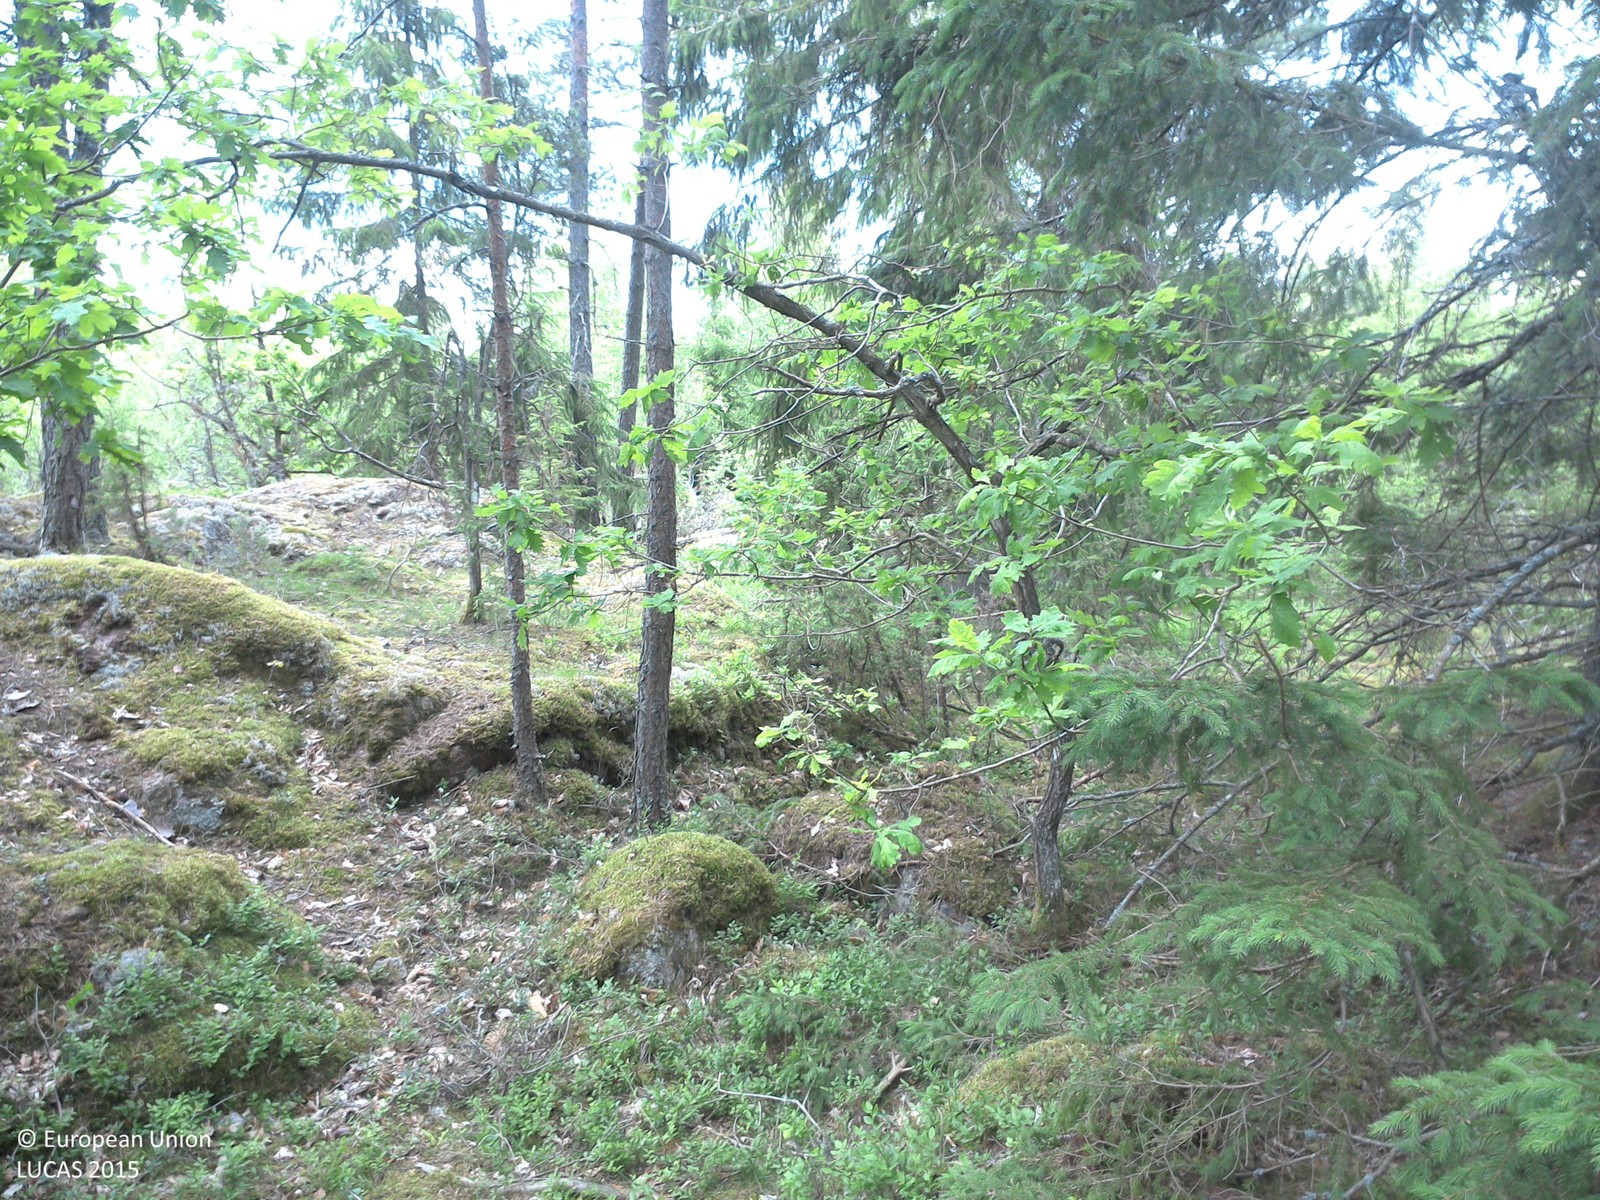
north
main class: Woodland
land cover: Pine dominated coniferous woodland
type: boreal forest
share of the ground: 50 - 75 %
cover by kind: coniferous forest trees 60 %, herbaceous plants 20 %, lichens and mosses 20 %
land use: Agriculture (excluding fallow land and kitchen gardens)
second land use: Forestry
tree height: > 5 m
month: June
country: SE
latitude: 58.3037
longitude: 15.5406
